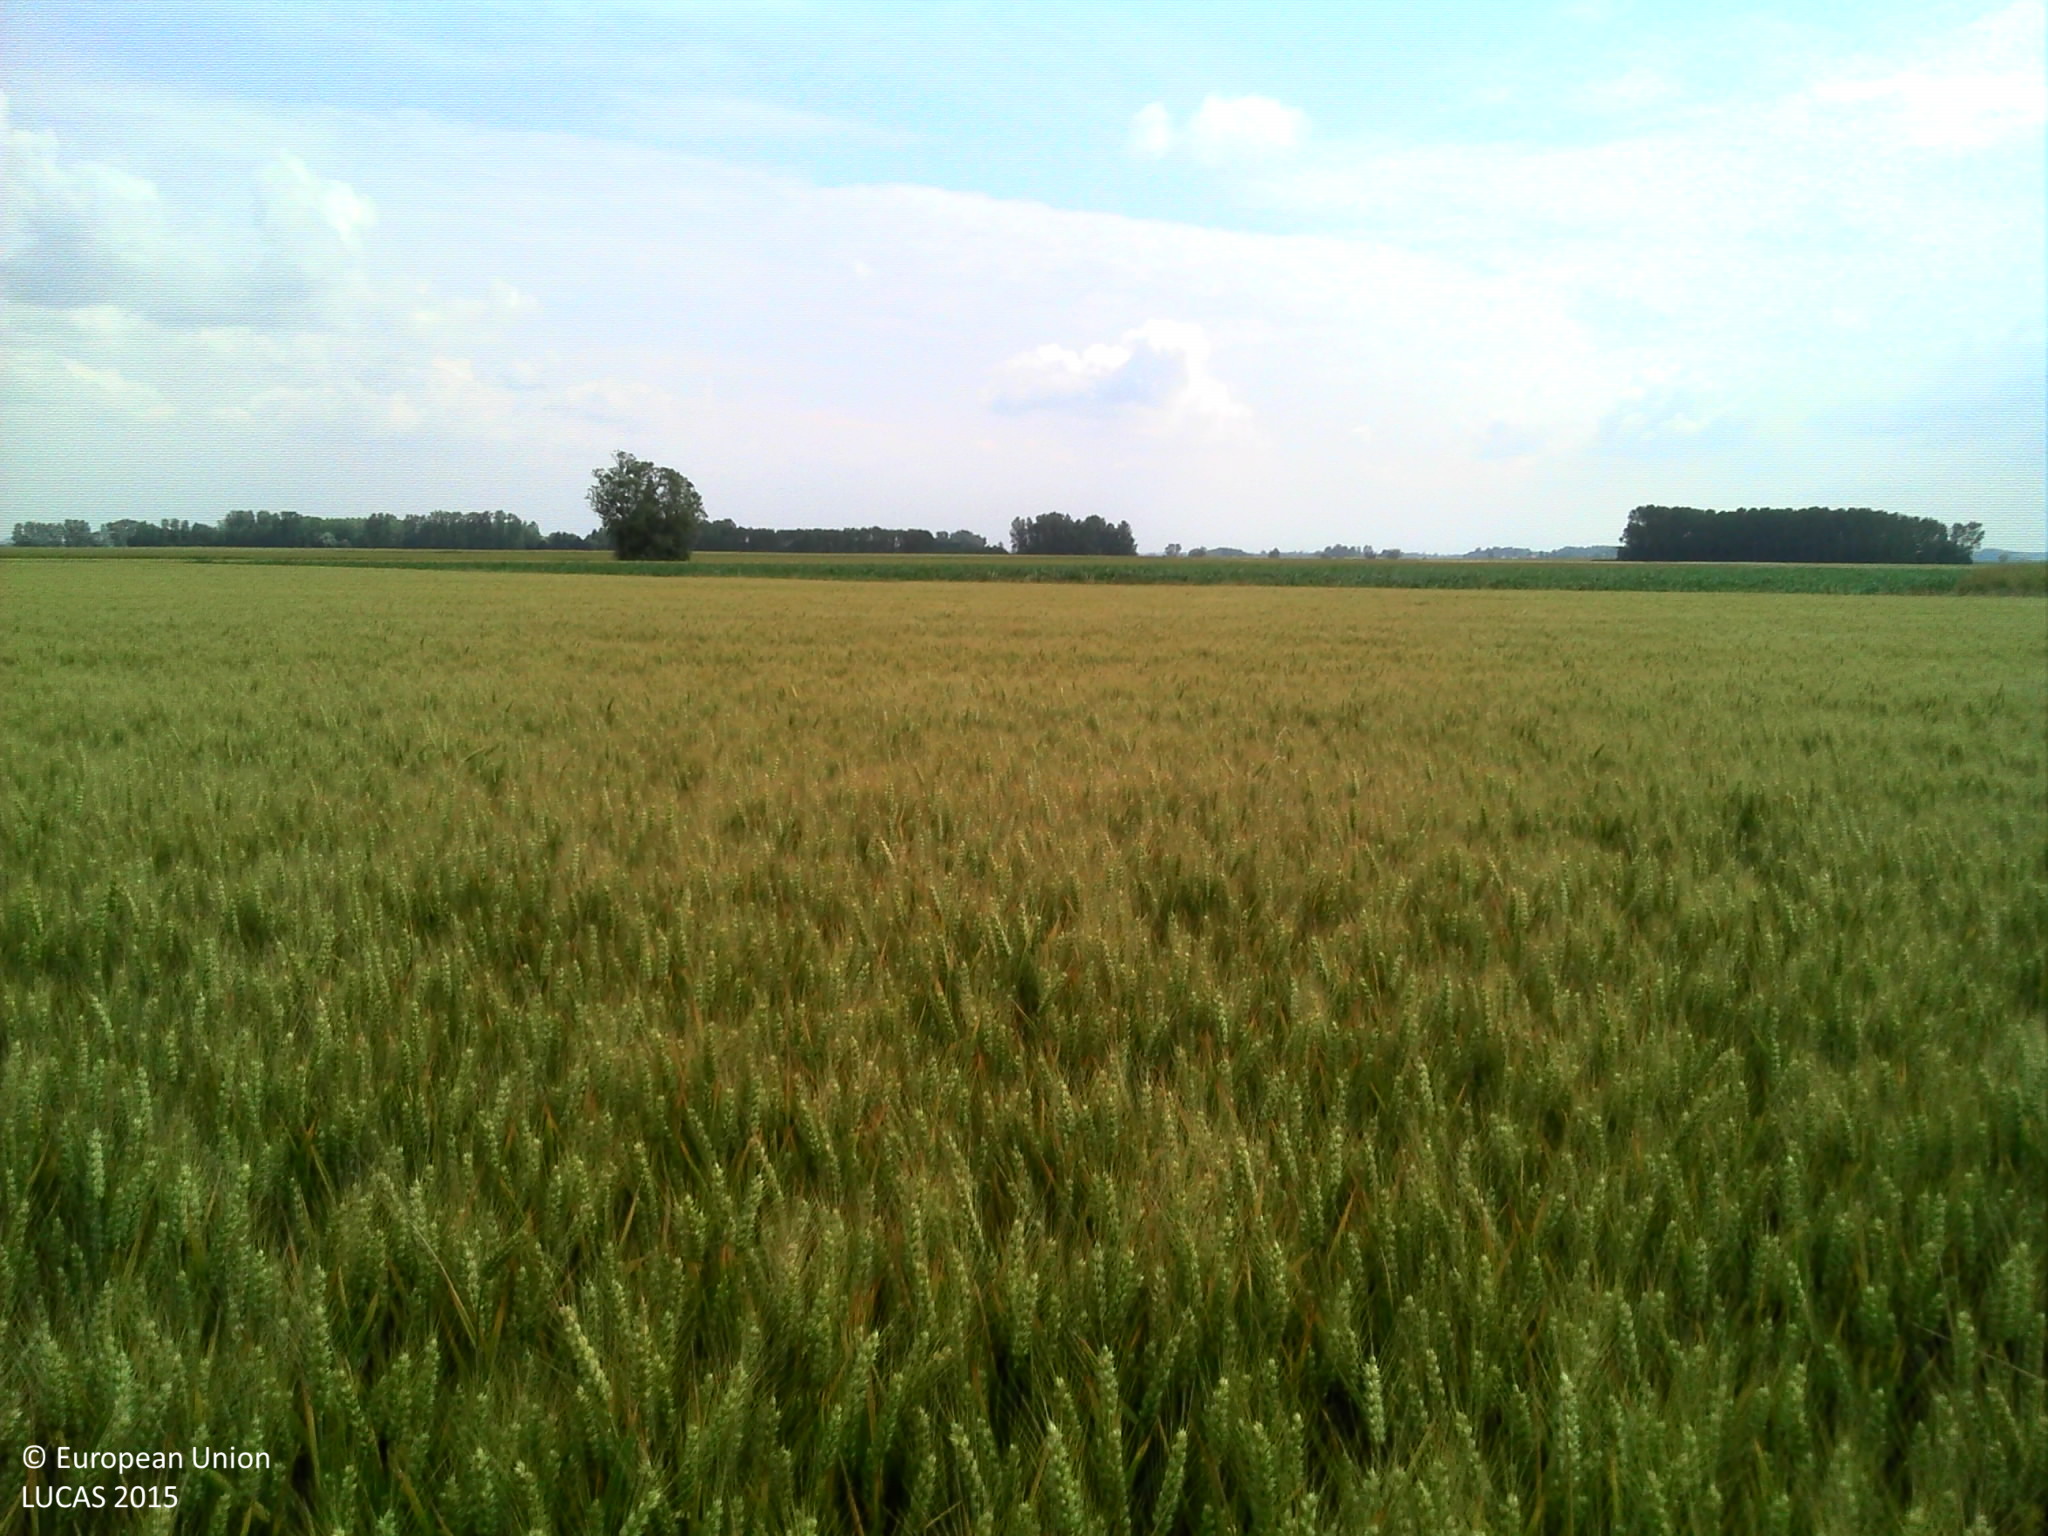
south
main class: Cropland
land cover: Common wheat
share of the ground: > 75 %
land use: Agriculture (excluding fallow land and kitchen gardens)
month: June
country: FR
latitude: 47.0237
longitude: 5.3044
